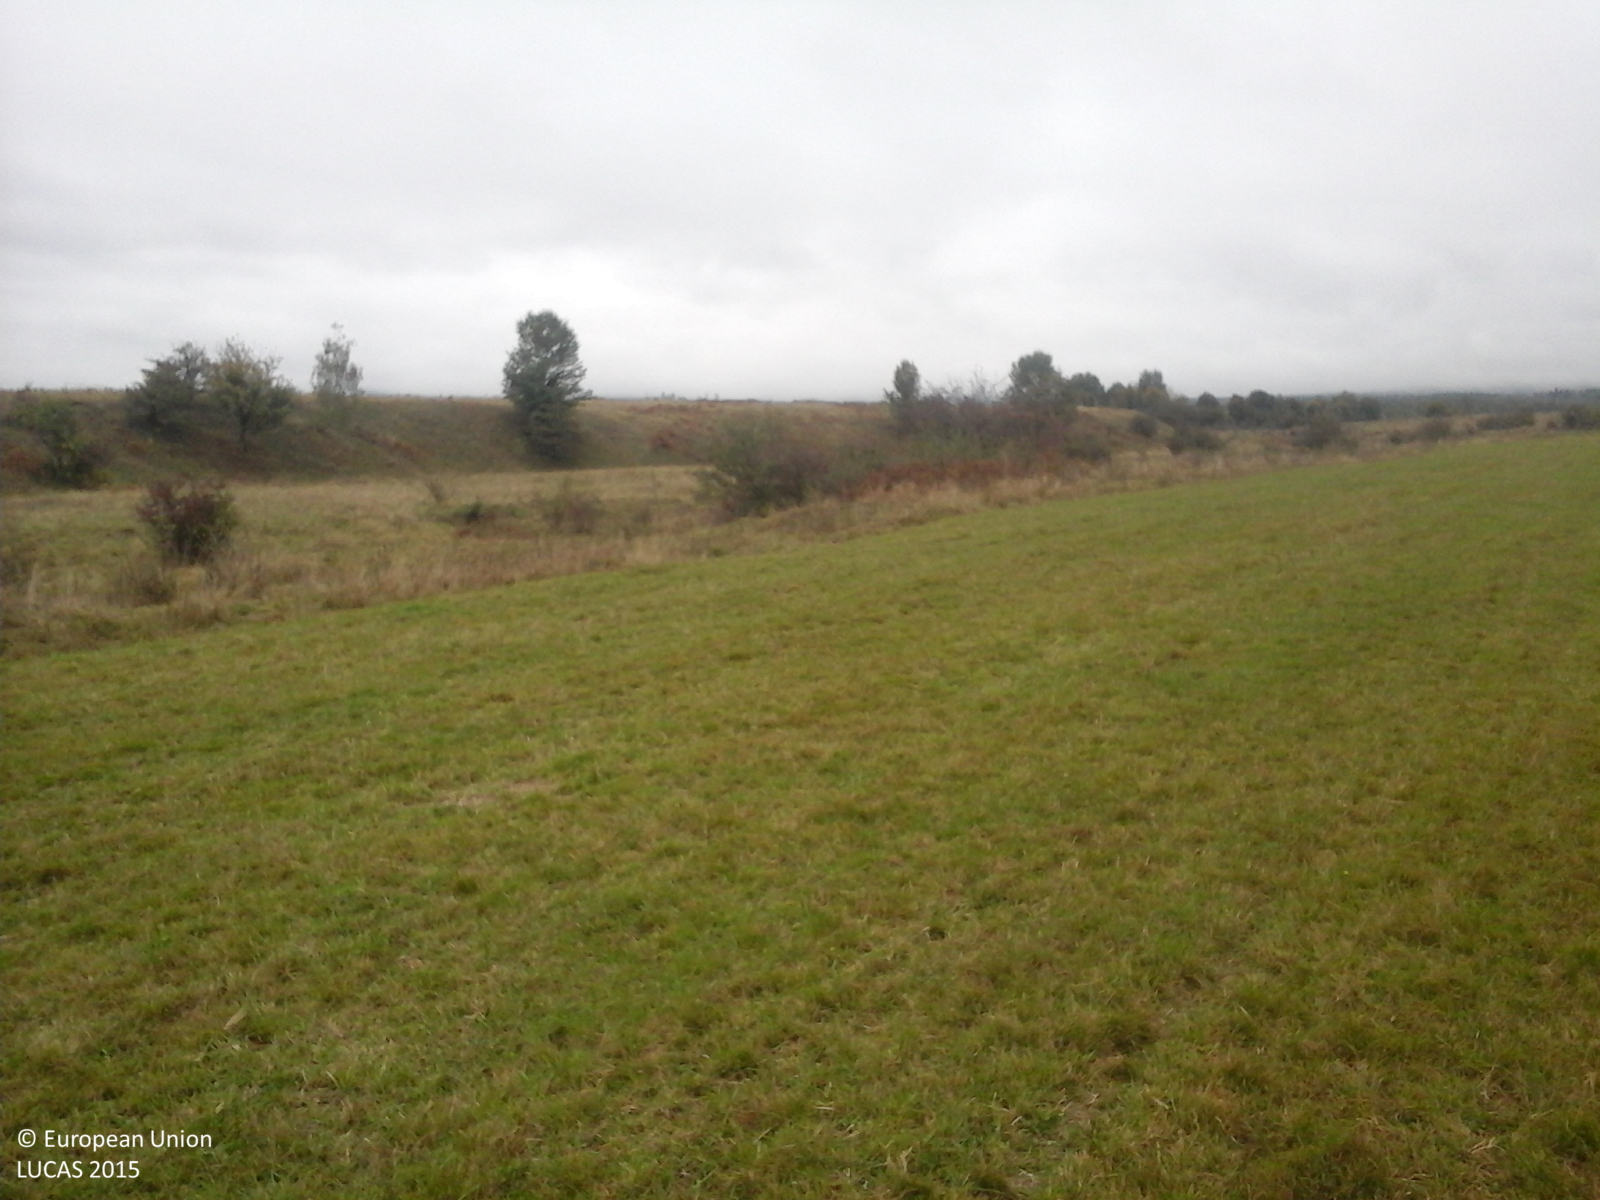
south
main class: Grassland
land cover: Grassland without tree/shrub cover
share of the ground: > 75 %
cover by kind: herbaceous plants 100 %
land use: Agriculture (excluding fallow land and kitchen gardens)
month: October
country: RO
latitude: 45.7282
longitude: 24.7215
